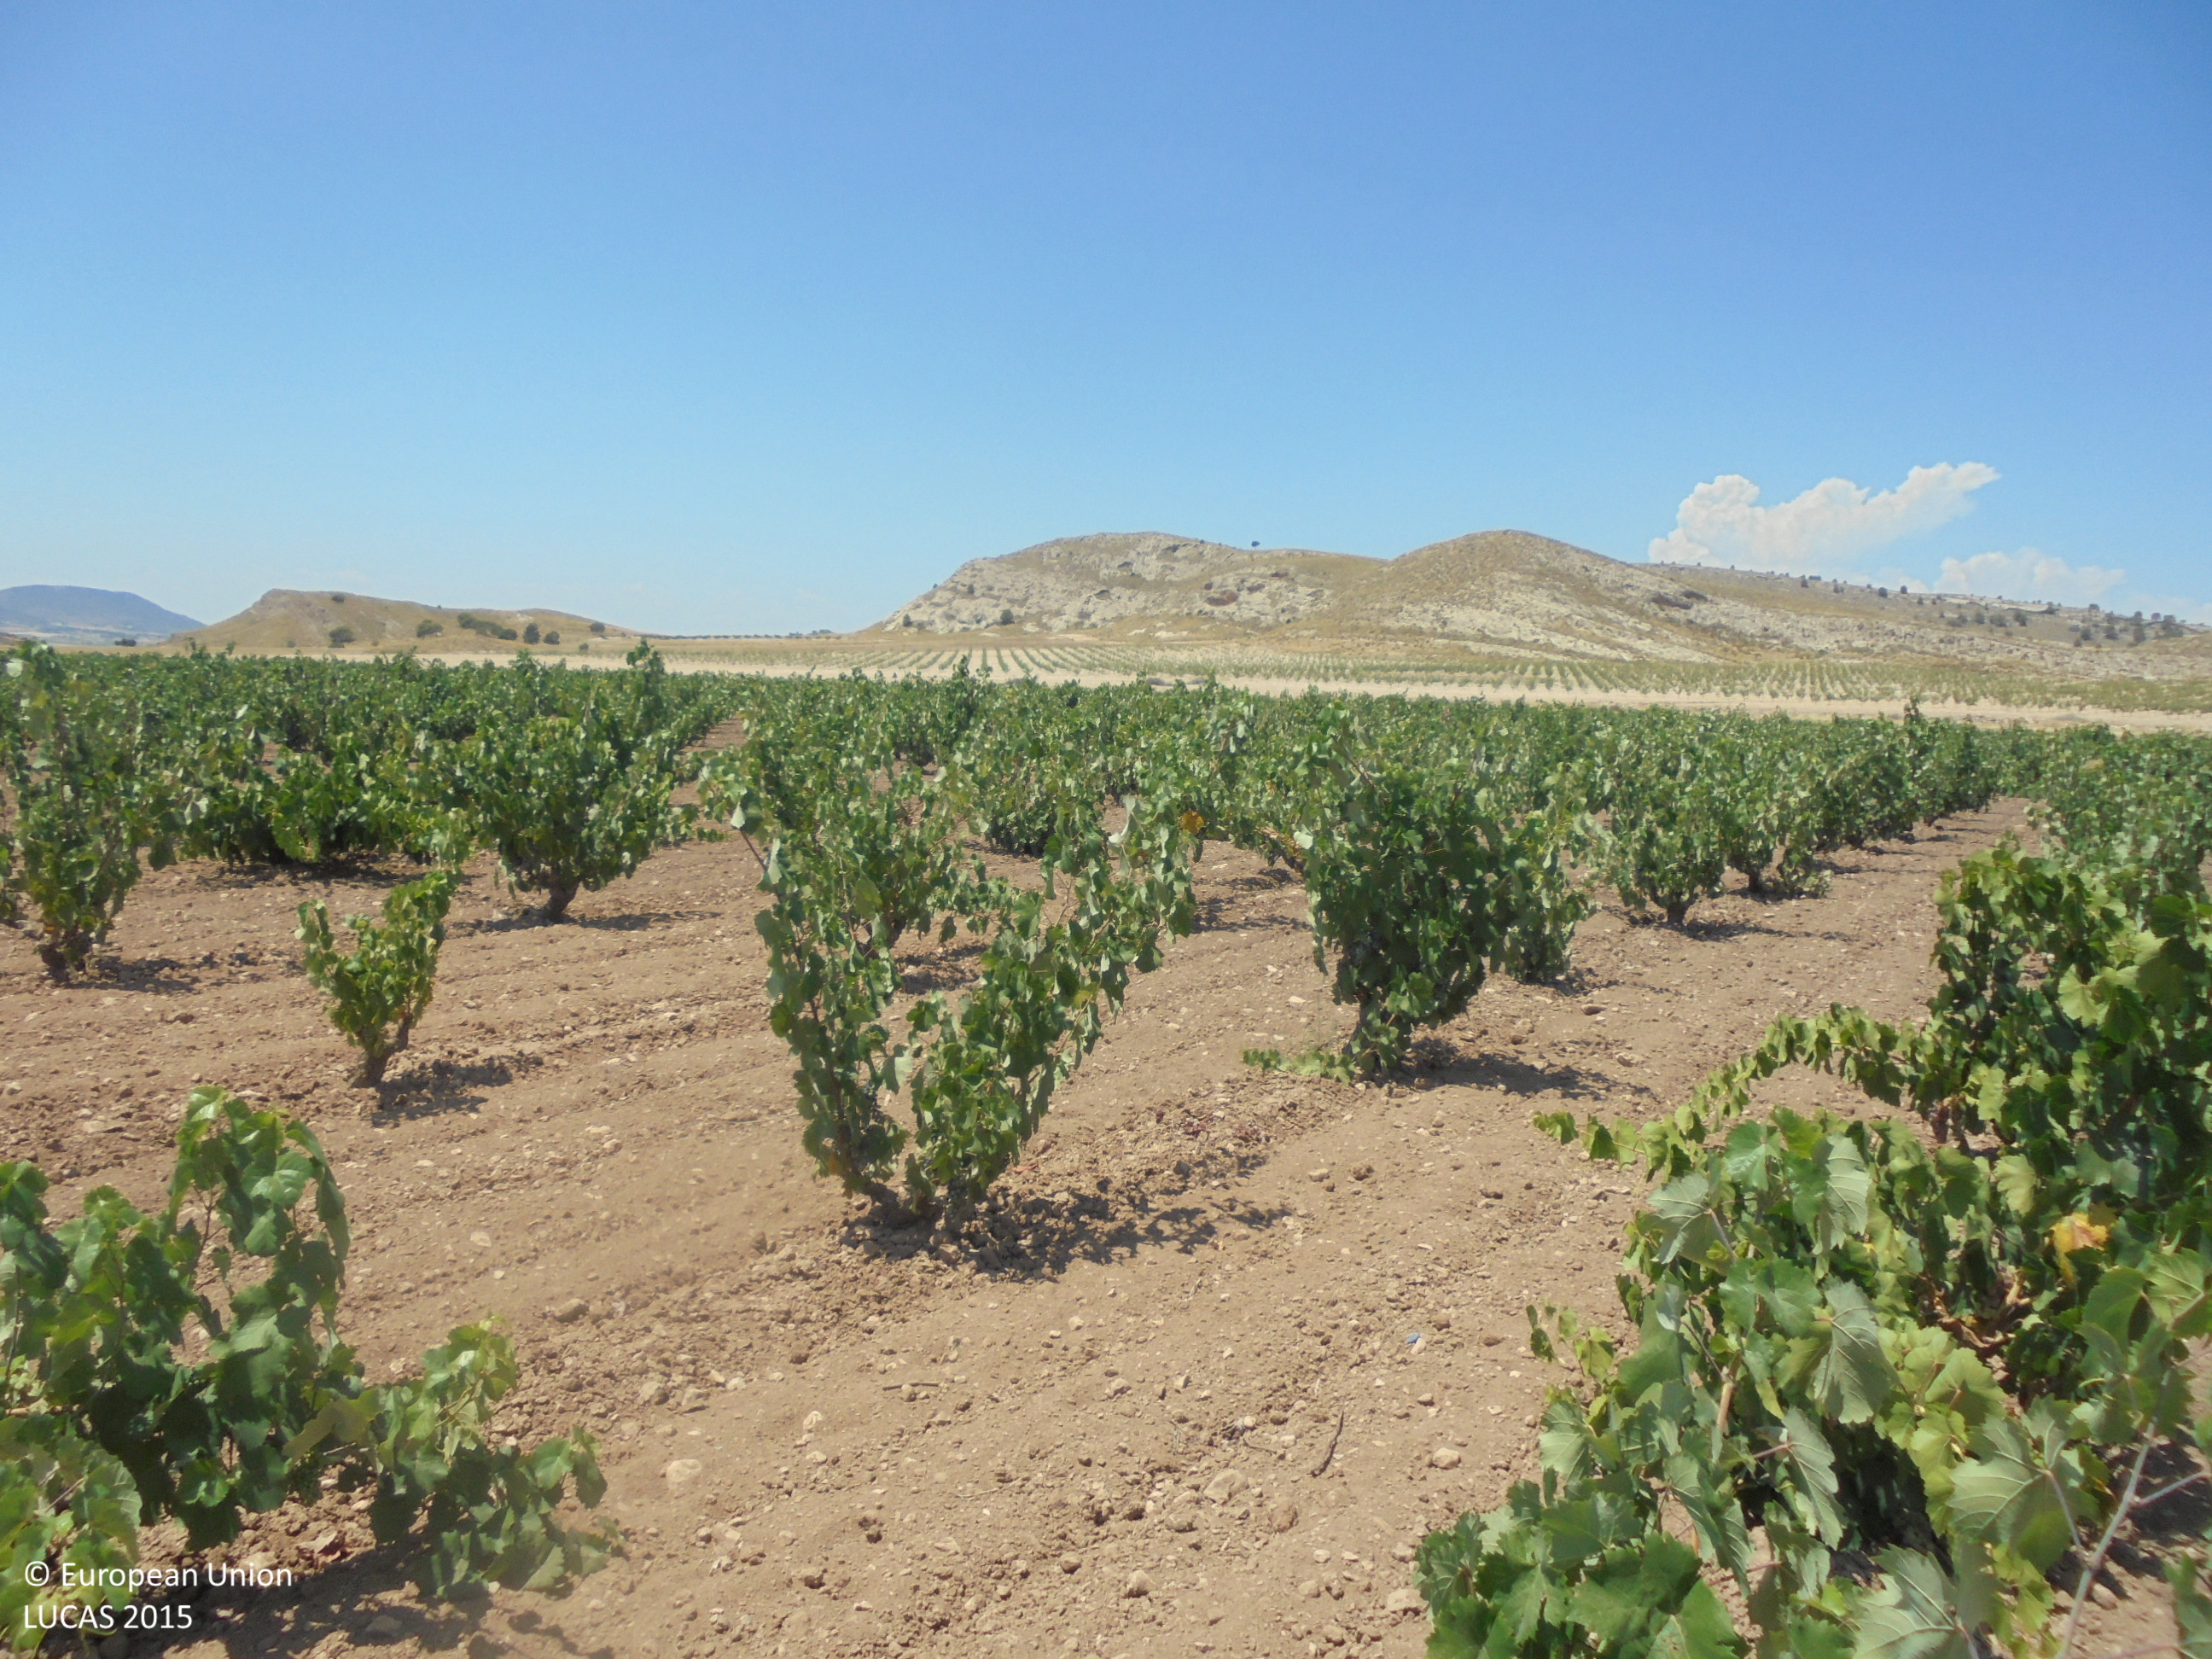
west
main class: Cropland
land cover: Vineyards
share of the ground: 25 - 50 %
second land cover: Other bare soil
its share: > 75 %
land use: Agriculture (excluding fallow land and kitchen gardens)
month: July
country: ES
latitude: 38.5429
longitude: -1.3848
